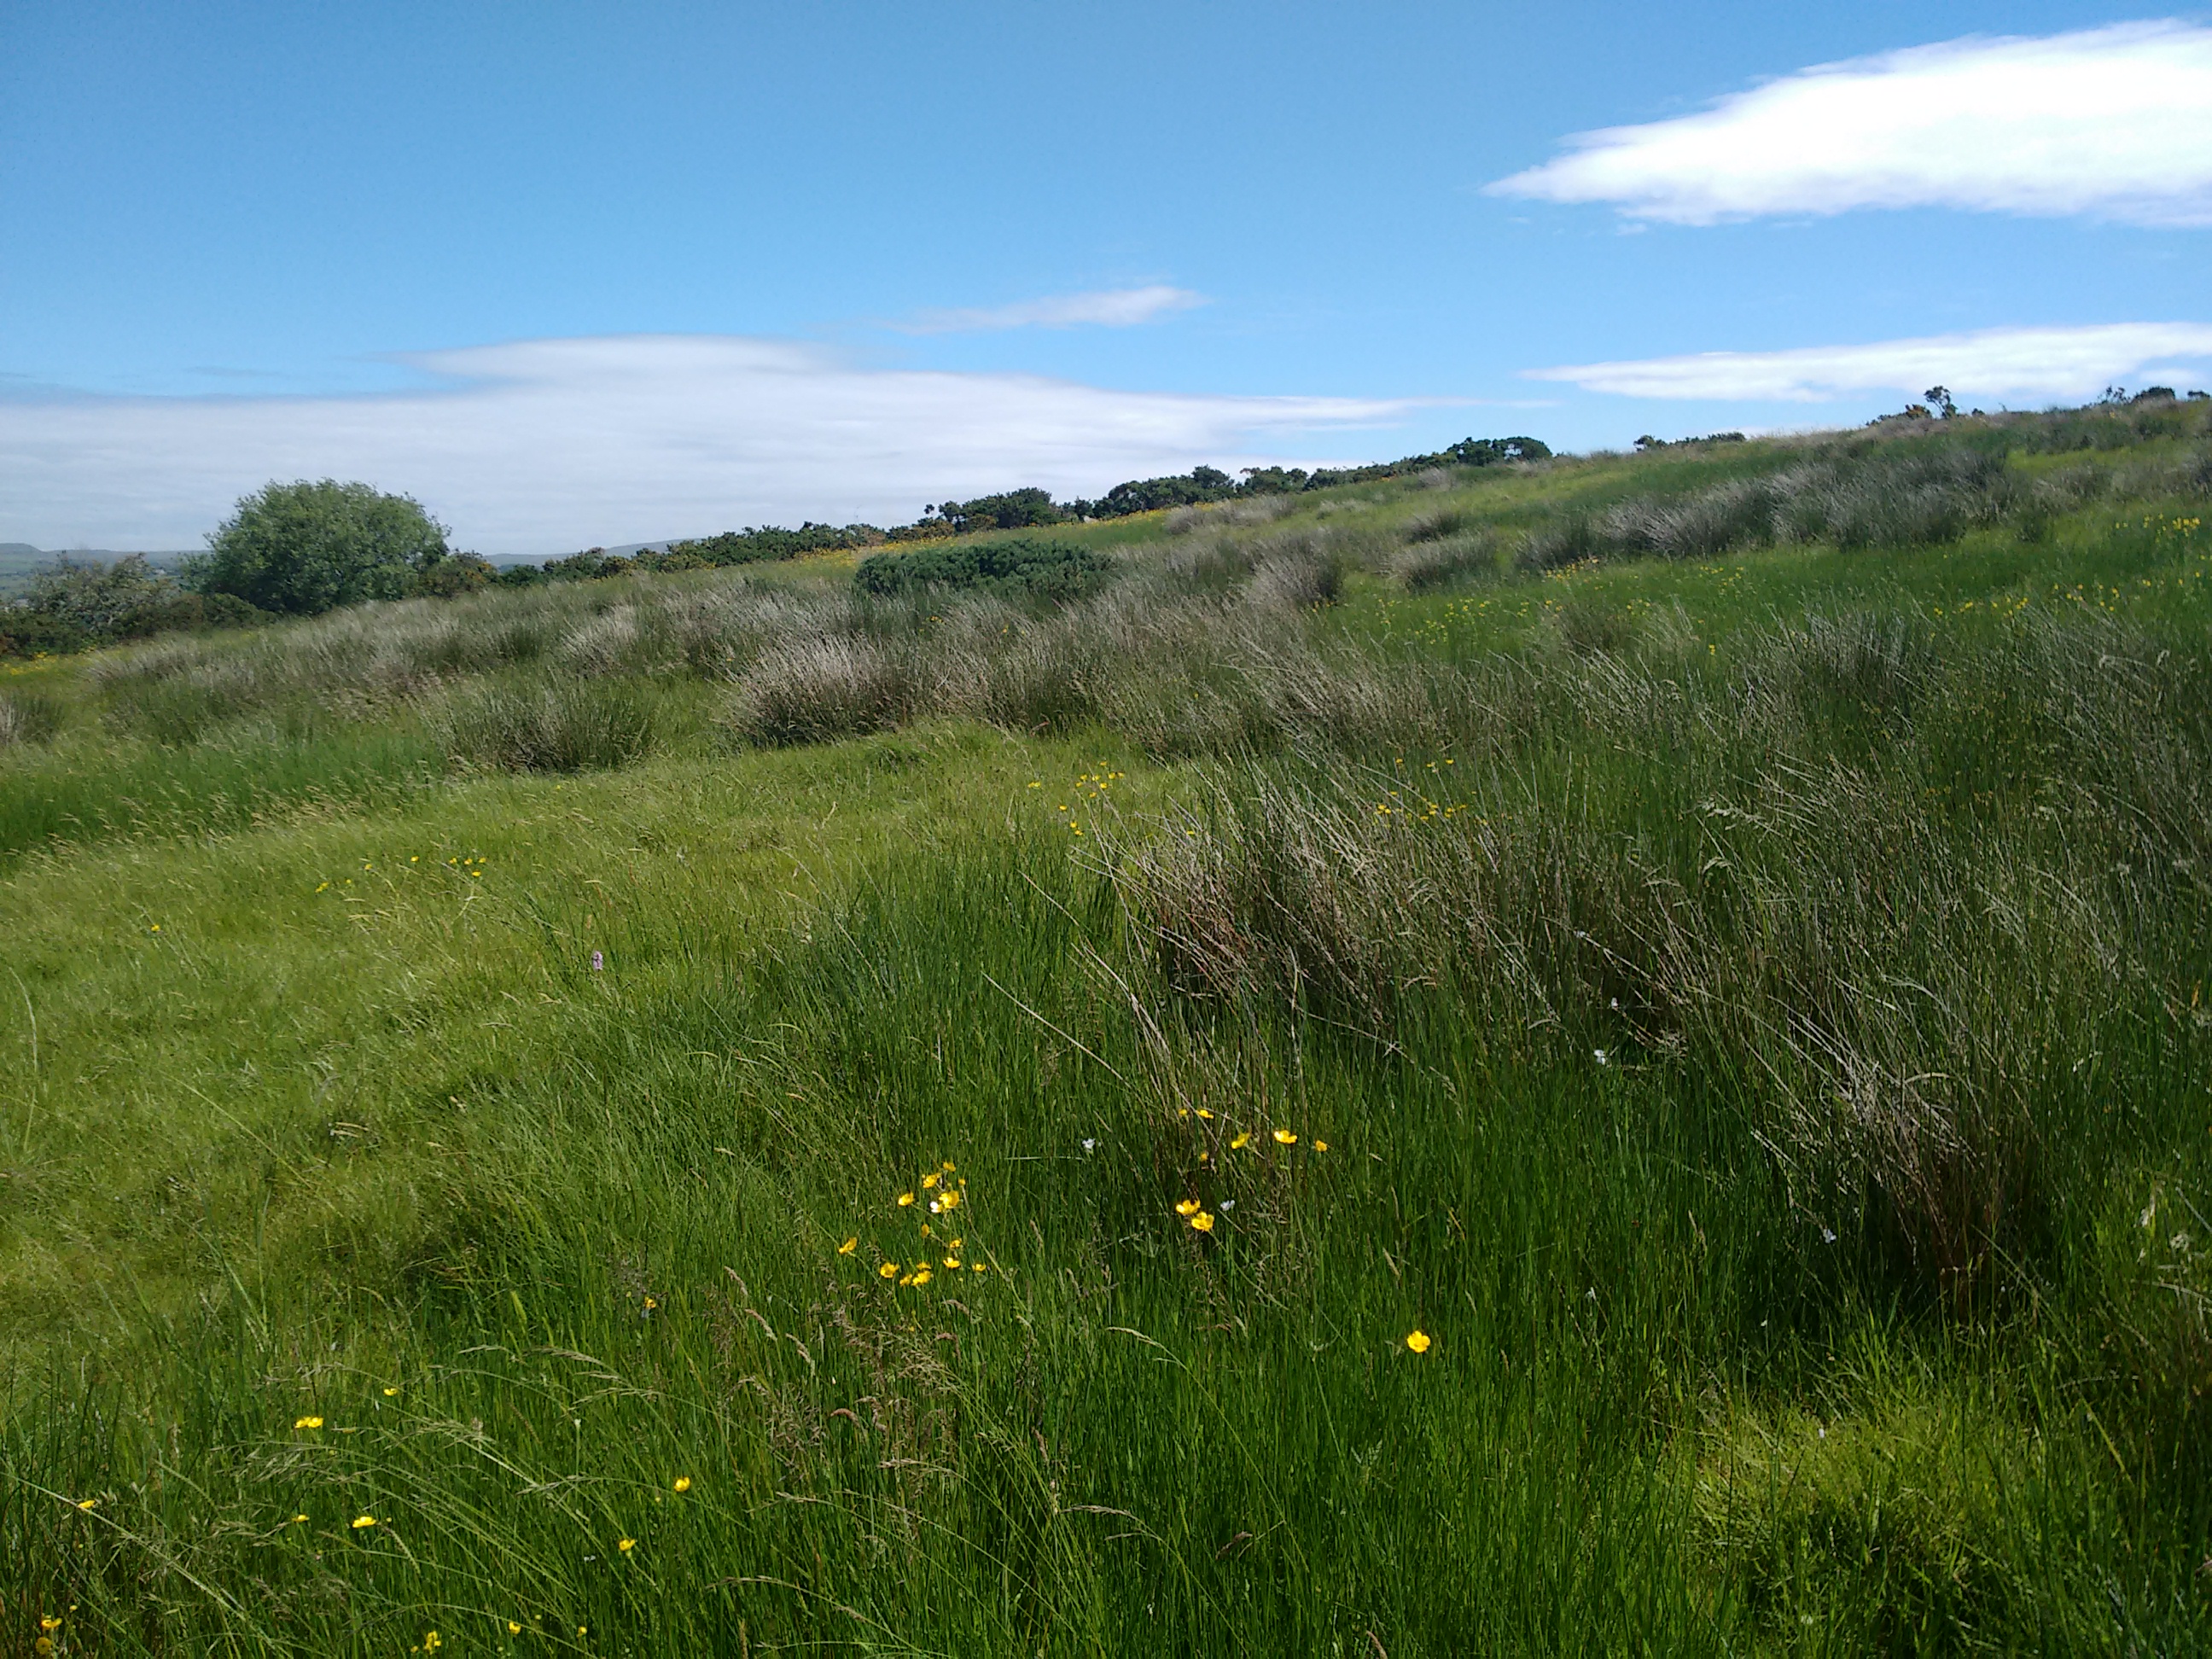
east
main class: Grassland
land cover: Grassland without tree/shrub cover
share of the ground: > 75 %
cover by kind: herbaceous plants 100 %
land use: Agriculture (excluding fallow land and kitchen gardens)
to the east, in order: Grassland without tree/shrub cover; Shruby margins; Ditches and canals; Grassland without tree/shrub cover; Abandoned hedges; Grassland without tree/shrub cover; Fences; Grassland without tree/shrub cover; Fences; Grassland without tree/shrub cover
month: June
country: GB
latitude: 55.1873
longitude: -6.1801
